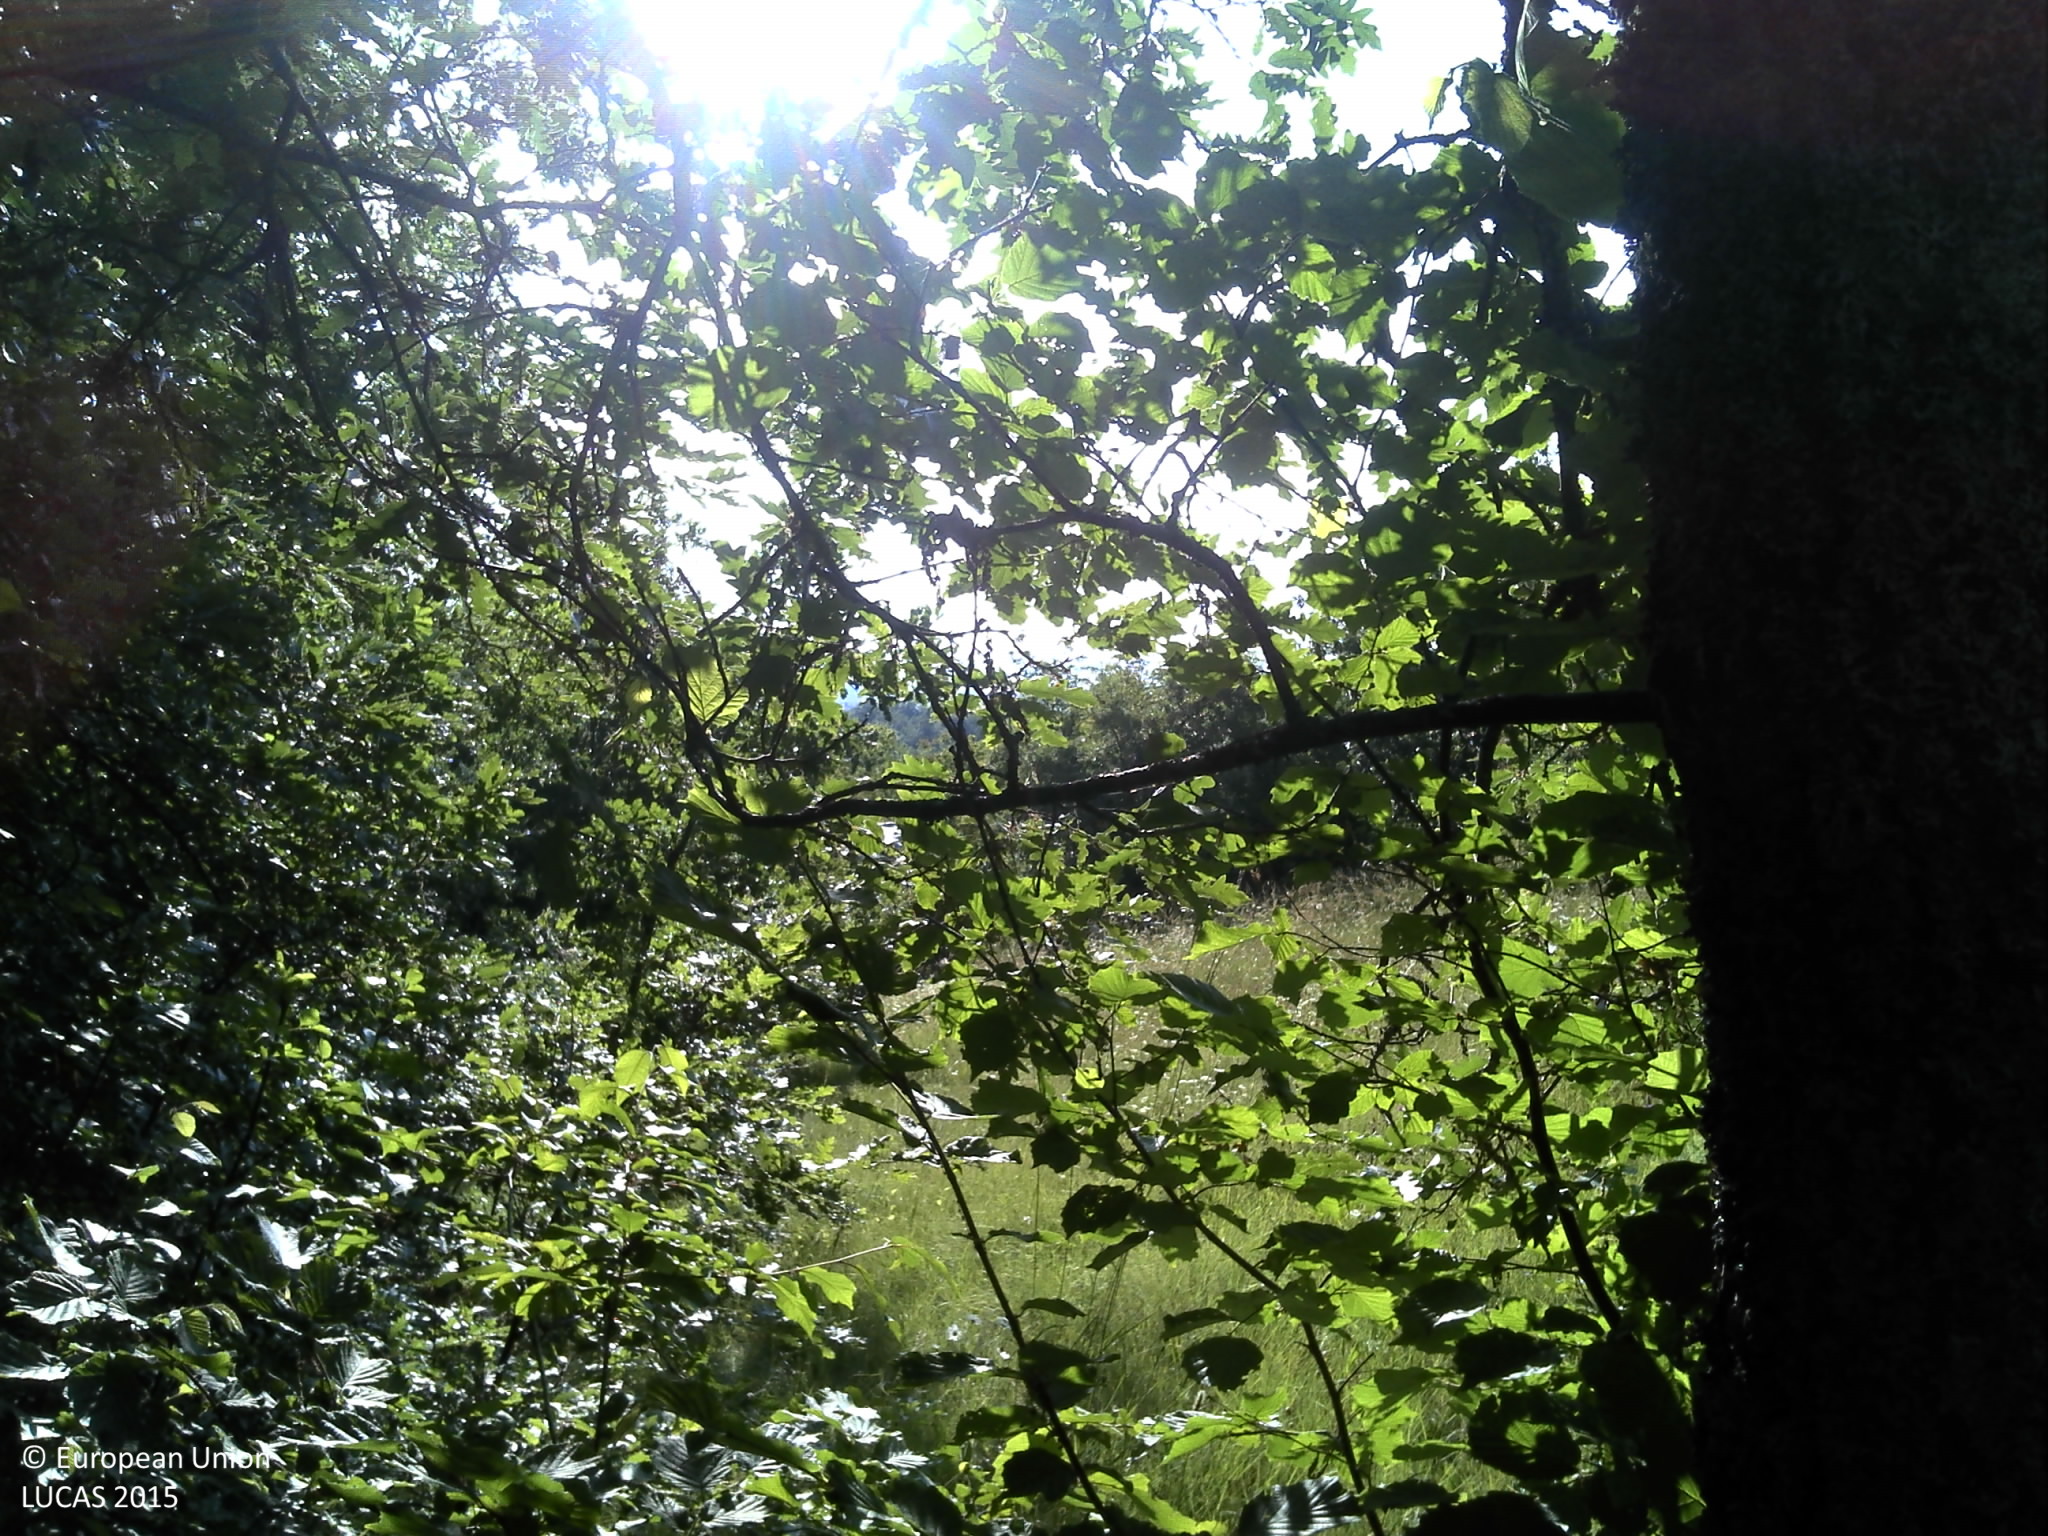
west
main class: Woodland
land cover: Broadleaved woodland
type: beech forest
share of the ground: 50 - 75 %
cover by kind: broadleaved forest trees 60 %, herbaceous plants 40 %
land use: Semi-natural and natural areas not in use
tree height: > 5 m
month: June
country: HR
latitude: 44.4325
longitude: 15.6338
